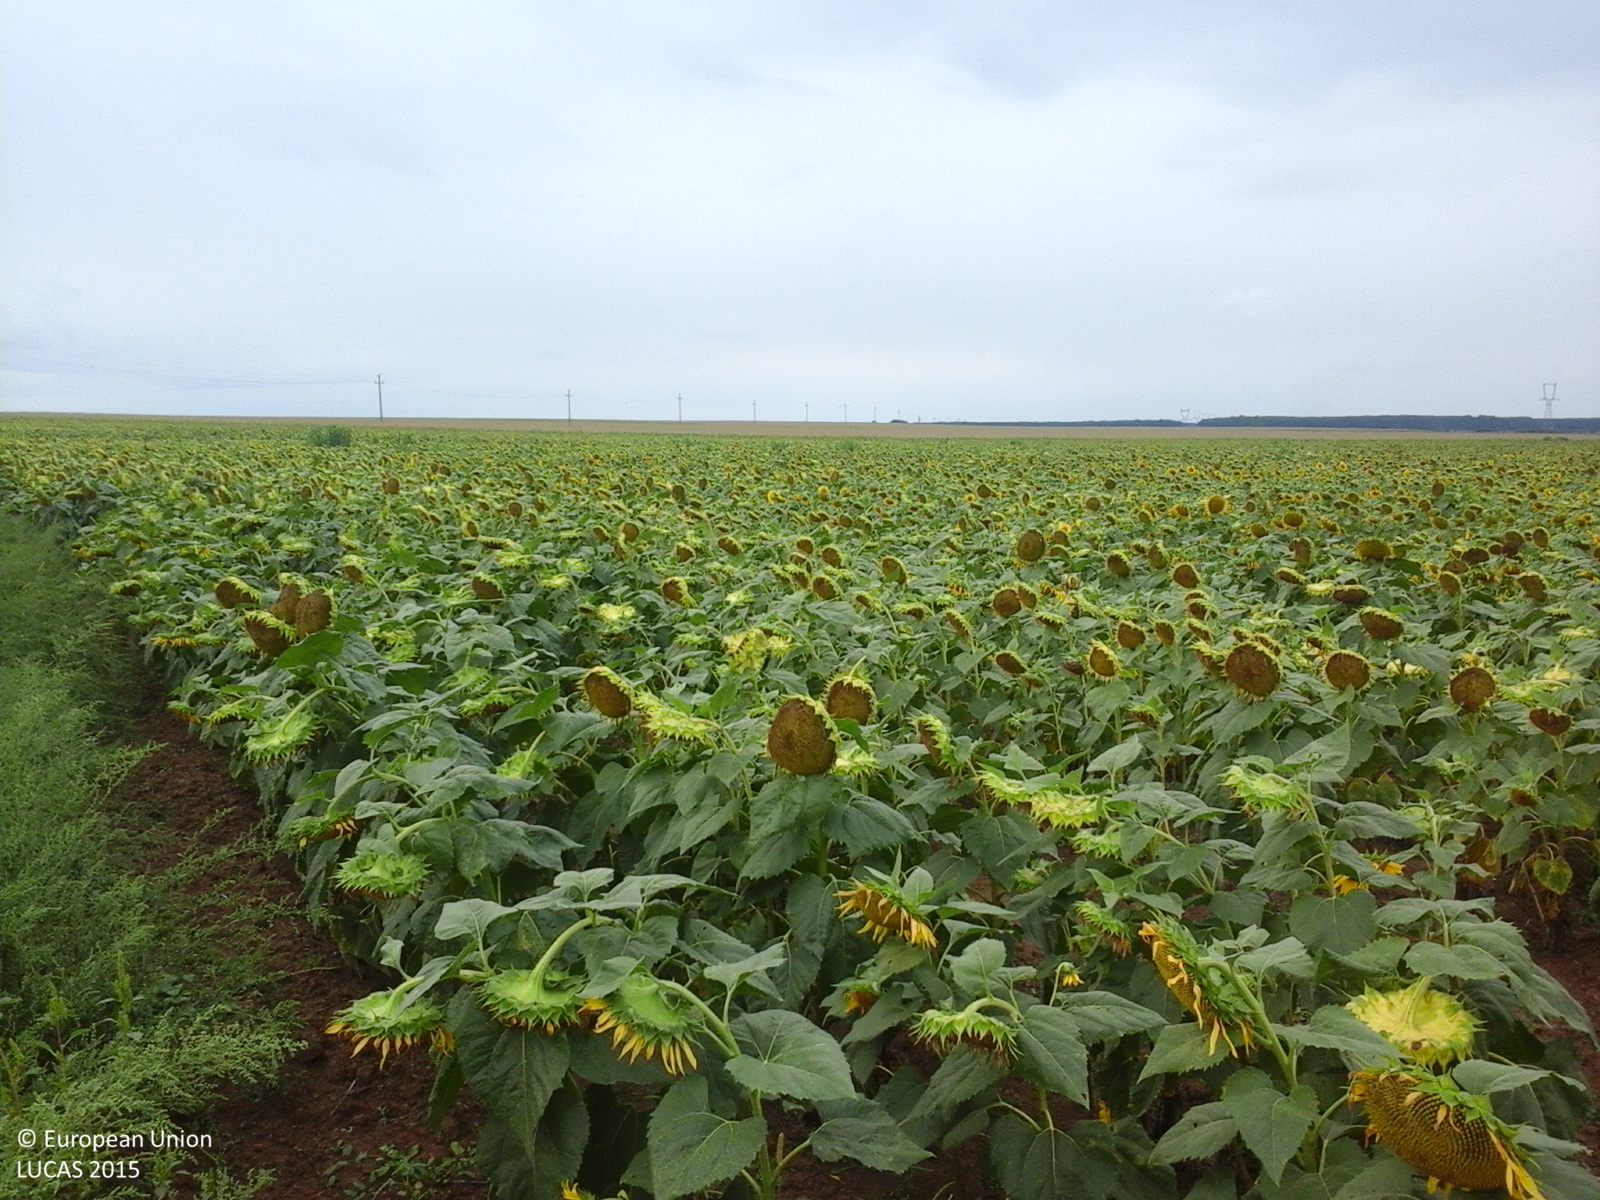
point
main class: Cropland
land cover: Sunflower
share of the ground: > 75 %
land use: Agriculture (excluding fallow land and kitchen gardens)
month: September
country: RO
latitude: 46.9624
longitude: 21.8595
